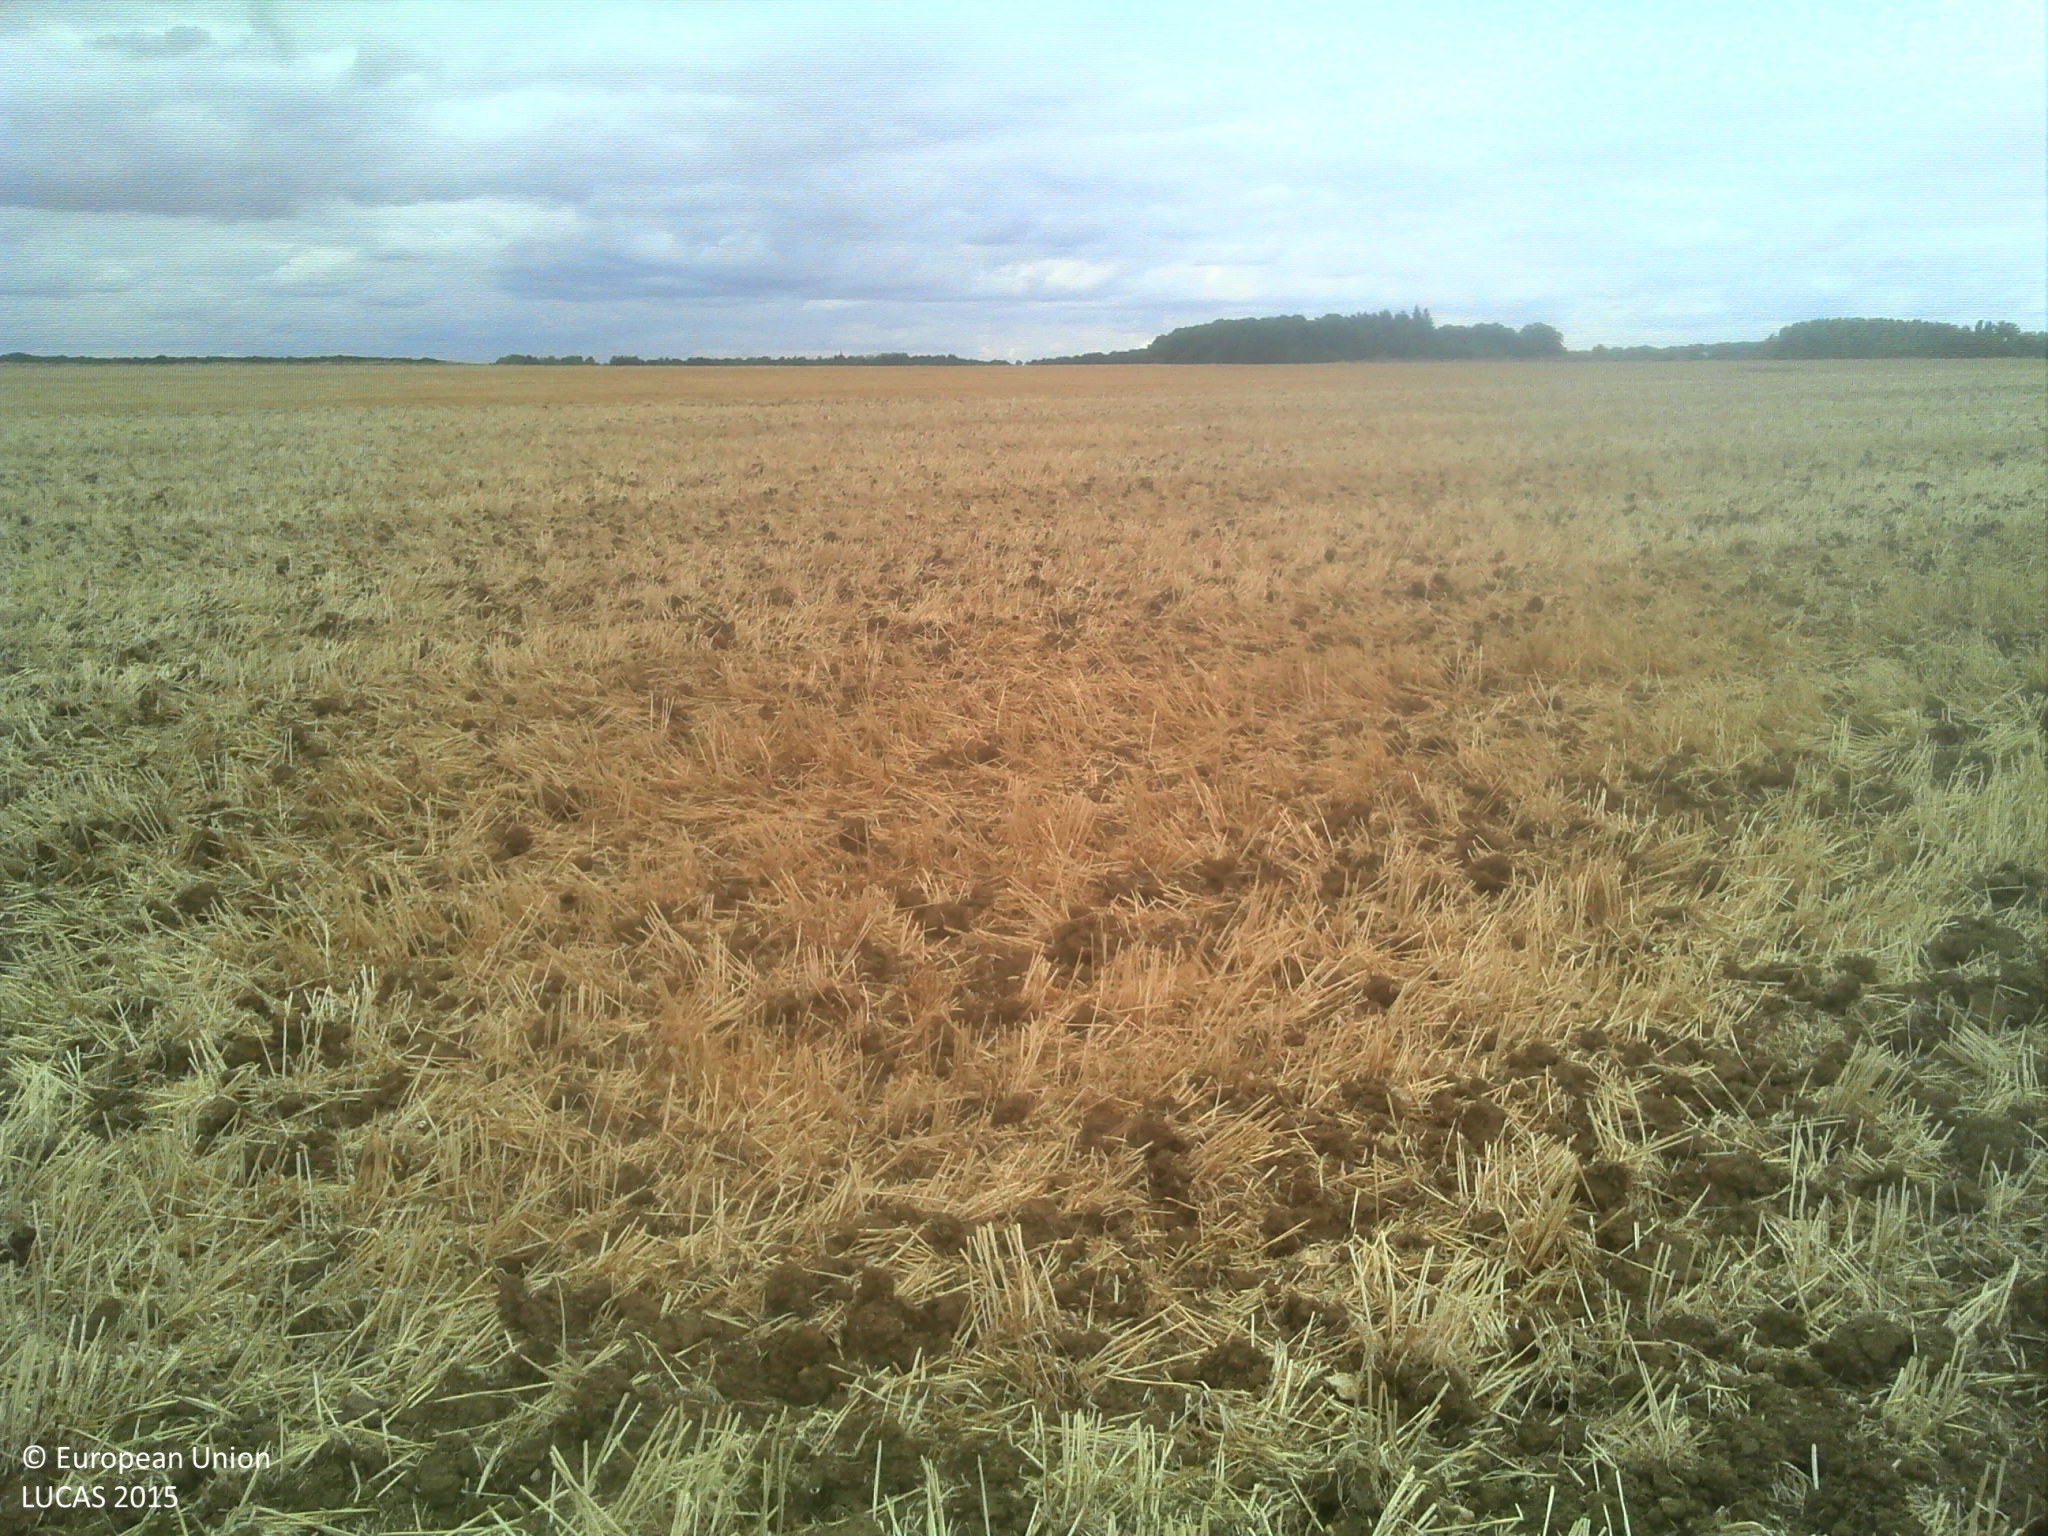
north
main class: Cropland
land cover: Common wheat
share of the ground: > 75 %
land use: Agriculture (excluding fallow land and kitchen gardens)
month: July
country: FR
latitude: 47.8438
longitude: 1.3115
